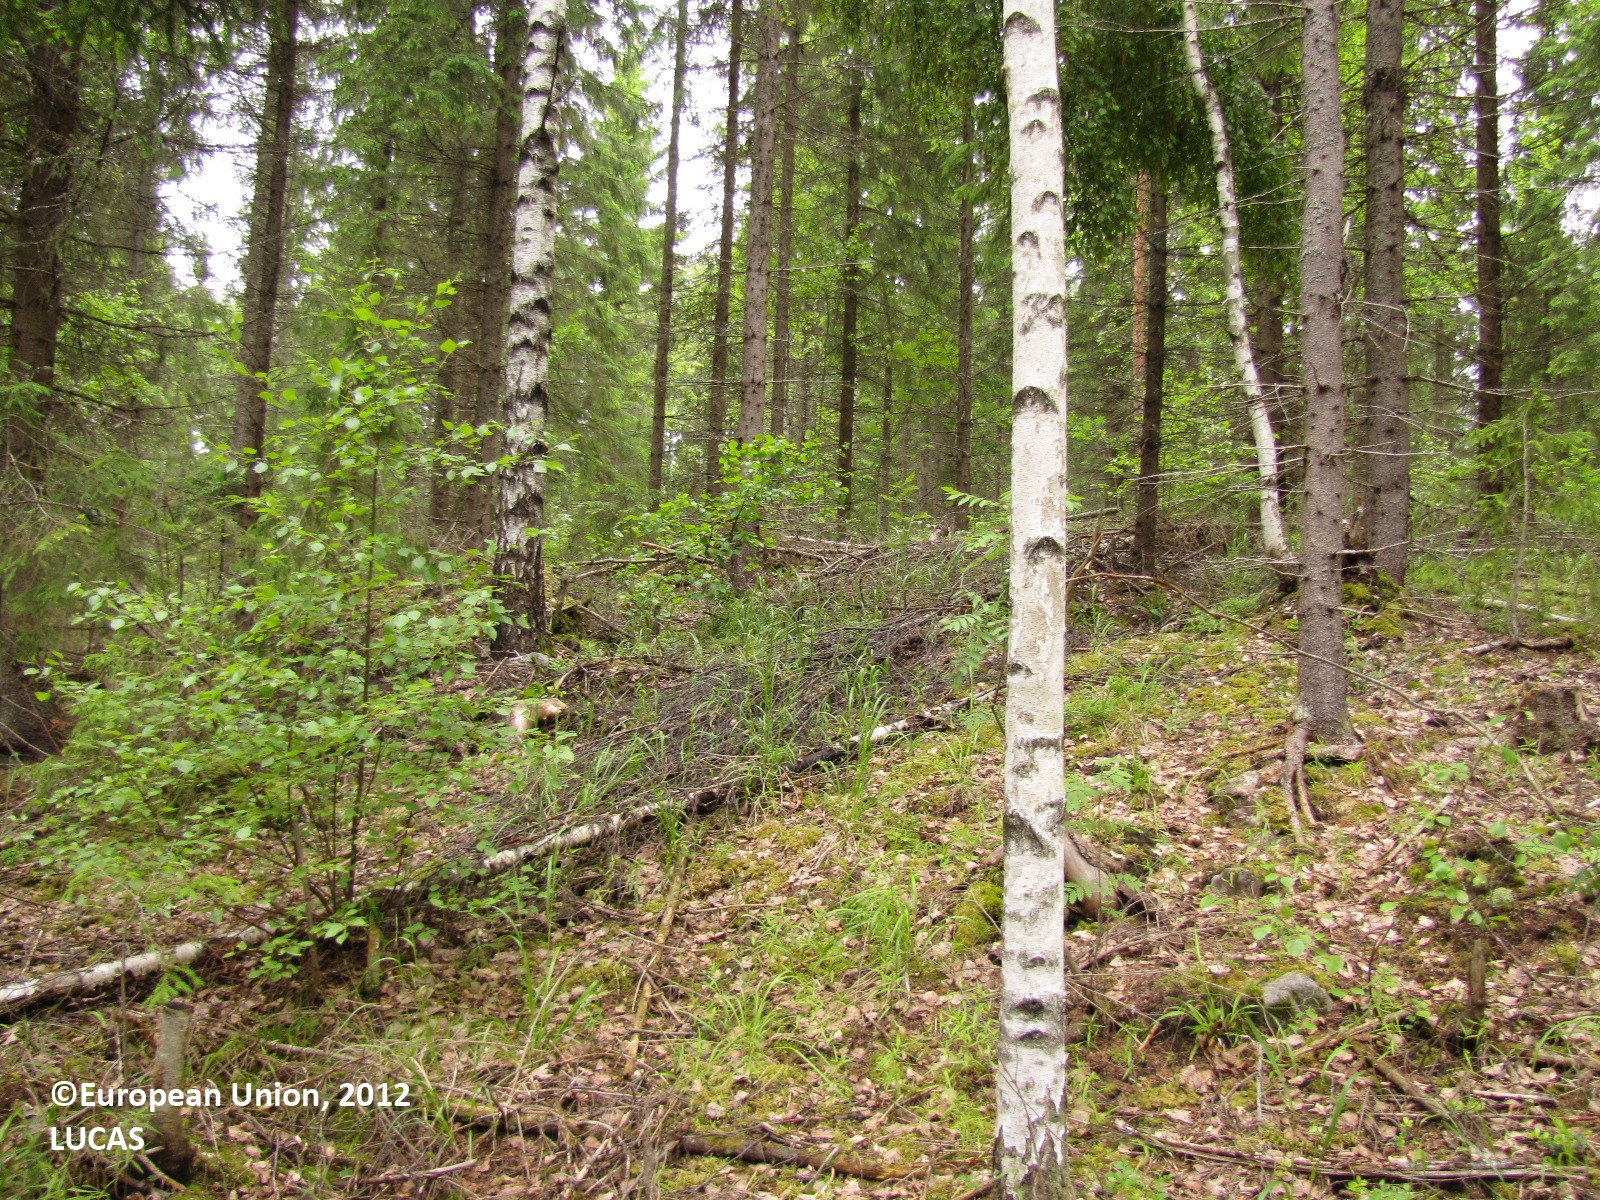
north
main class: Woodland
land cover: Spruce dominated mixed woodland
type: boreal forest
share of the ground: 50 - 75 %
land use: Forestry
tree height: > 5 m
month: June
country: FI
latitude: 61.2437
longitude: 24.3143
